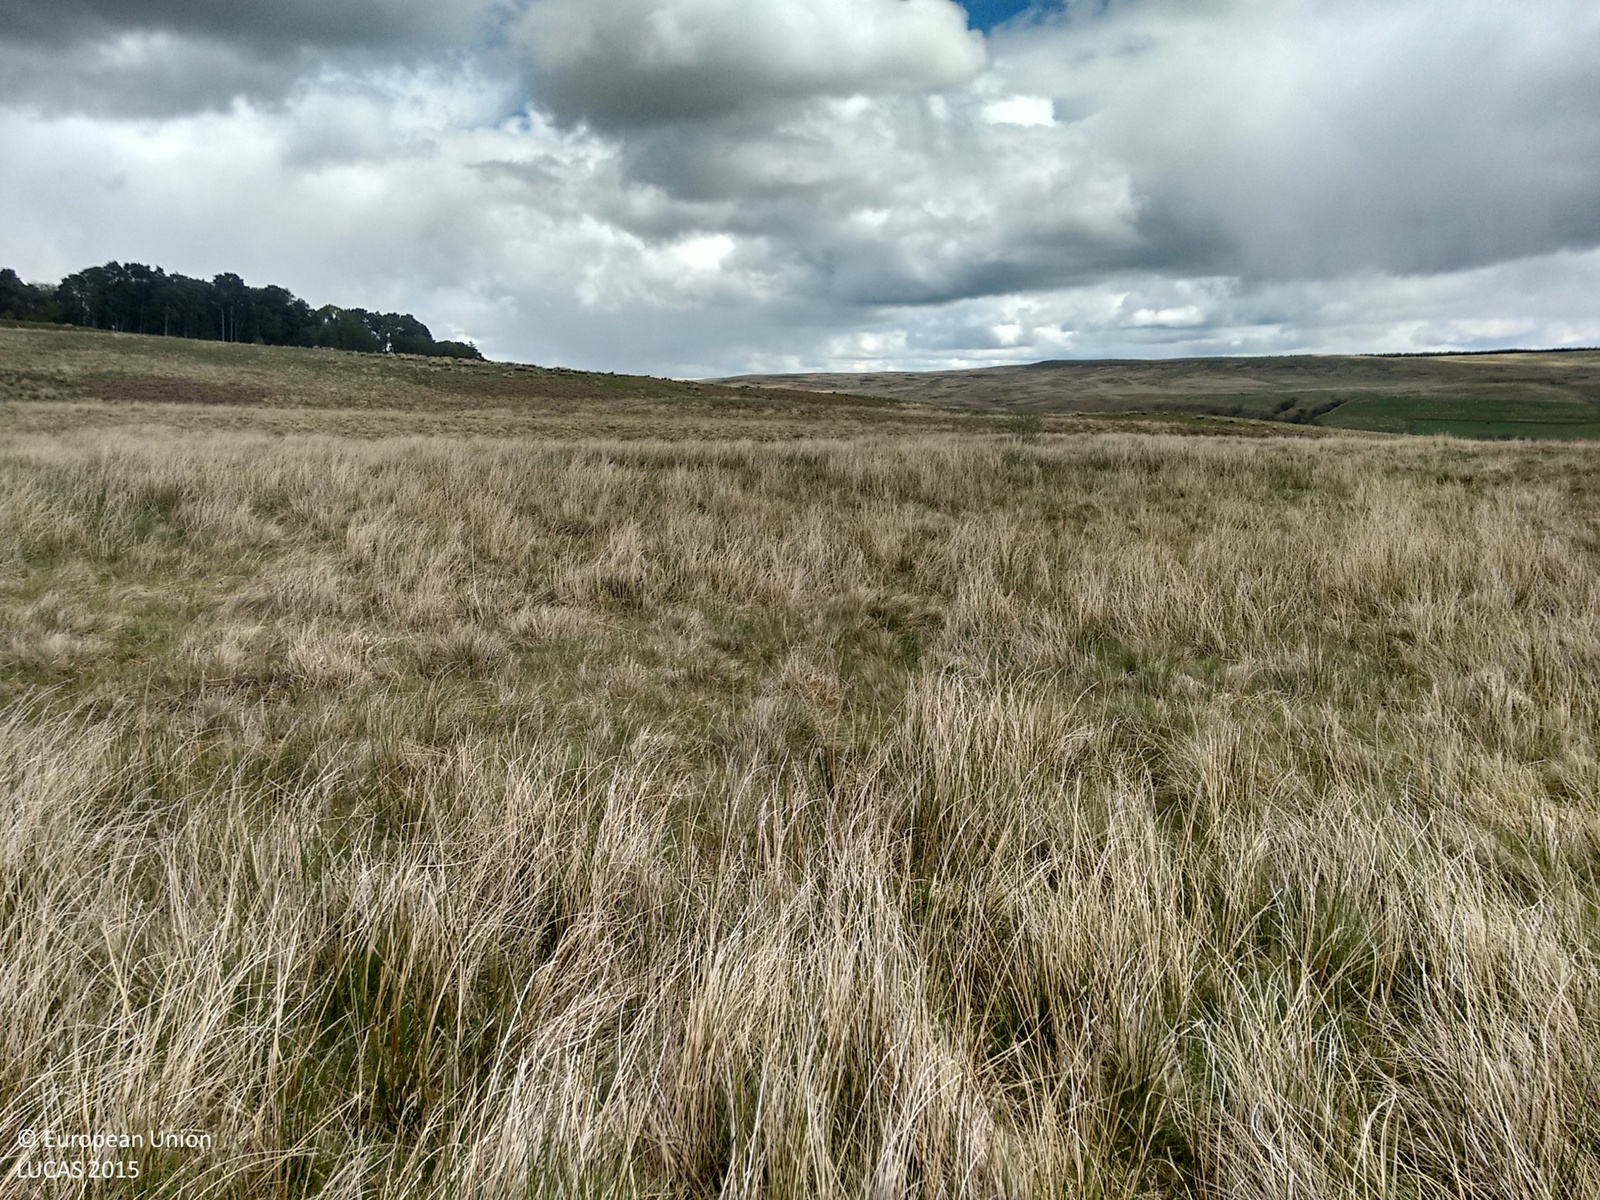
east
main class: Grassland
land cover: Grassland without tree/shrub cover
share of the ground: > 75 %
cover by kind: herbaceous plants 100 %
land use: Agriculture (excluding fallow land and kitchen gardens)
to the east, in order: Grassland without tree/shrub cover; Rivers and streams; Grassland without tree/shrub cover
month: May
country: GB
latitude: 55.3021
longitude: -2.2974
